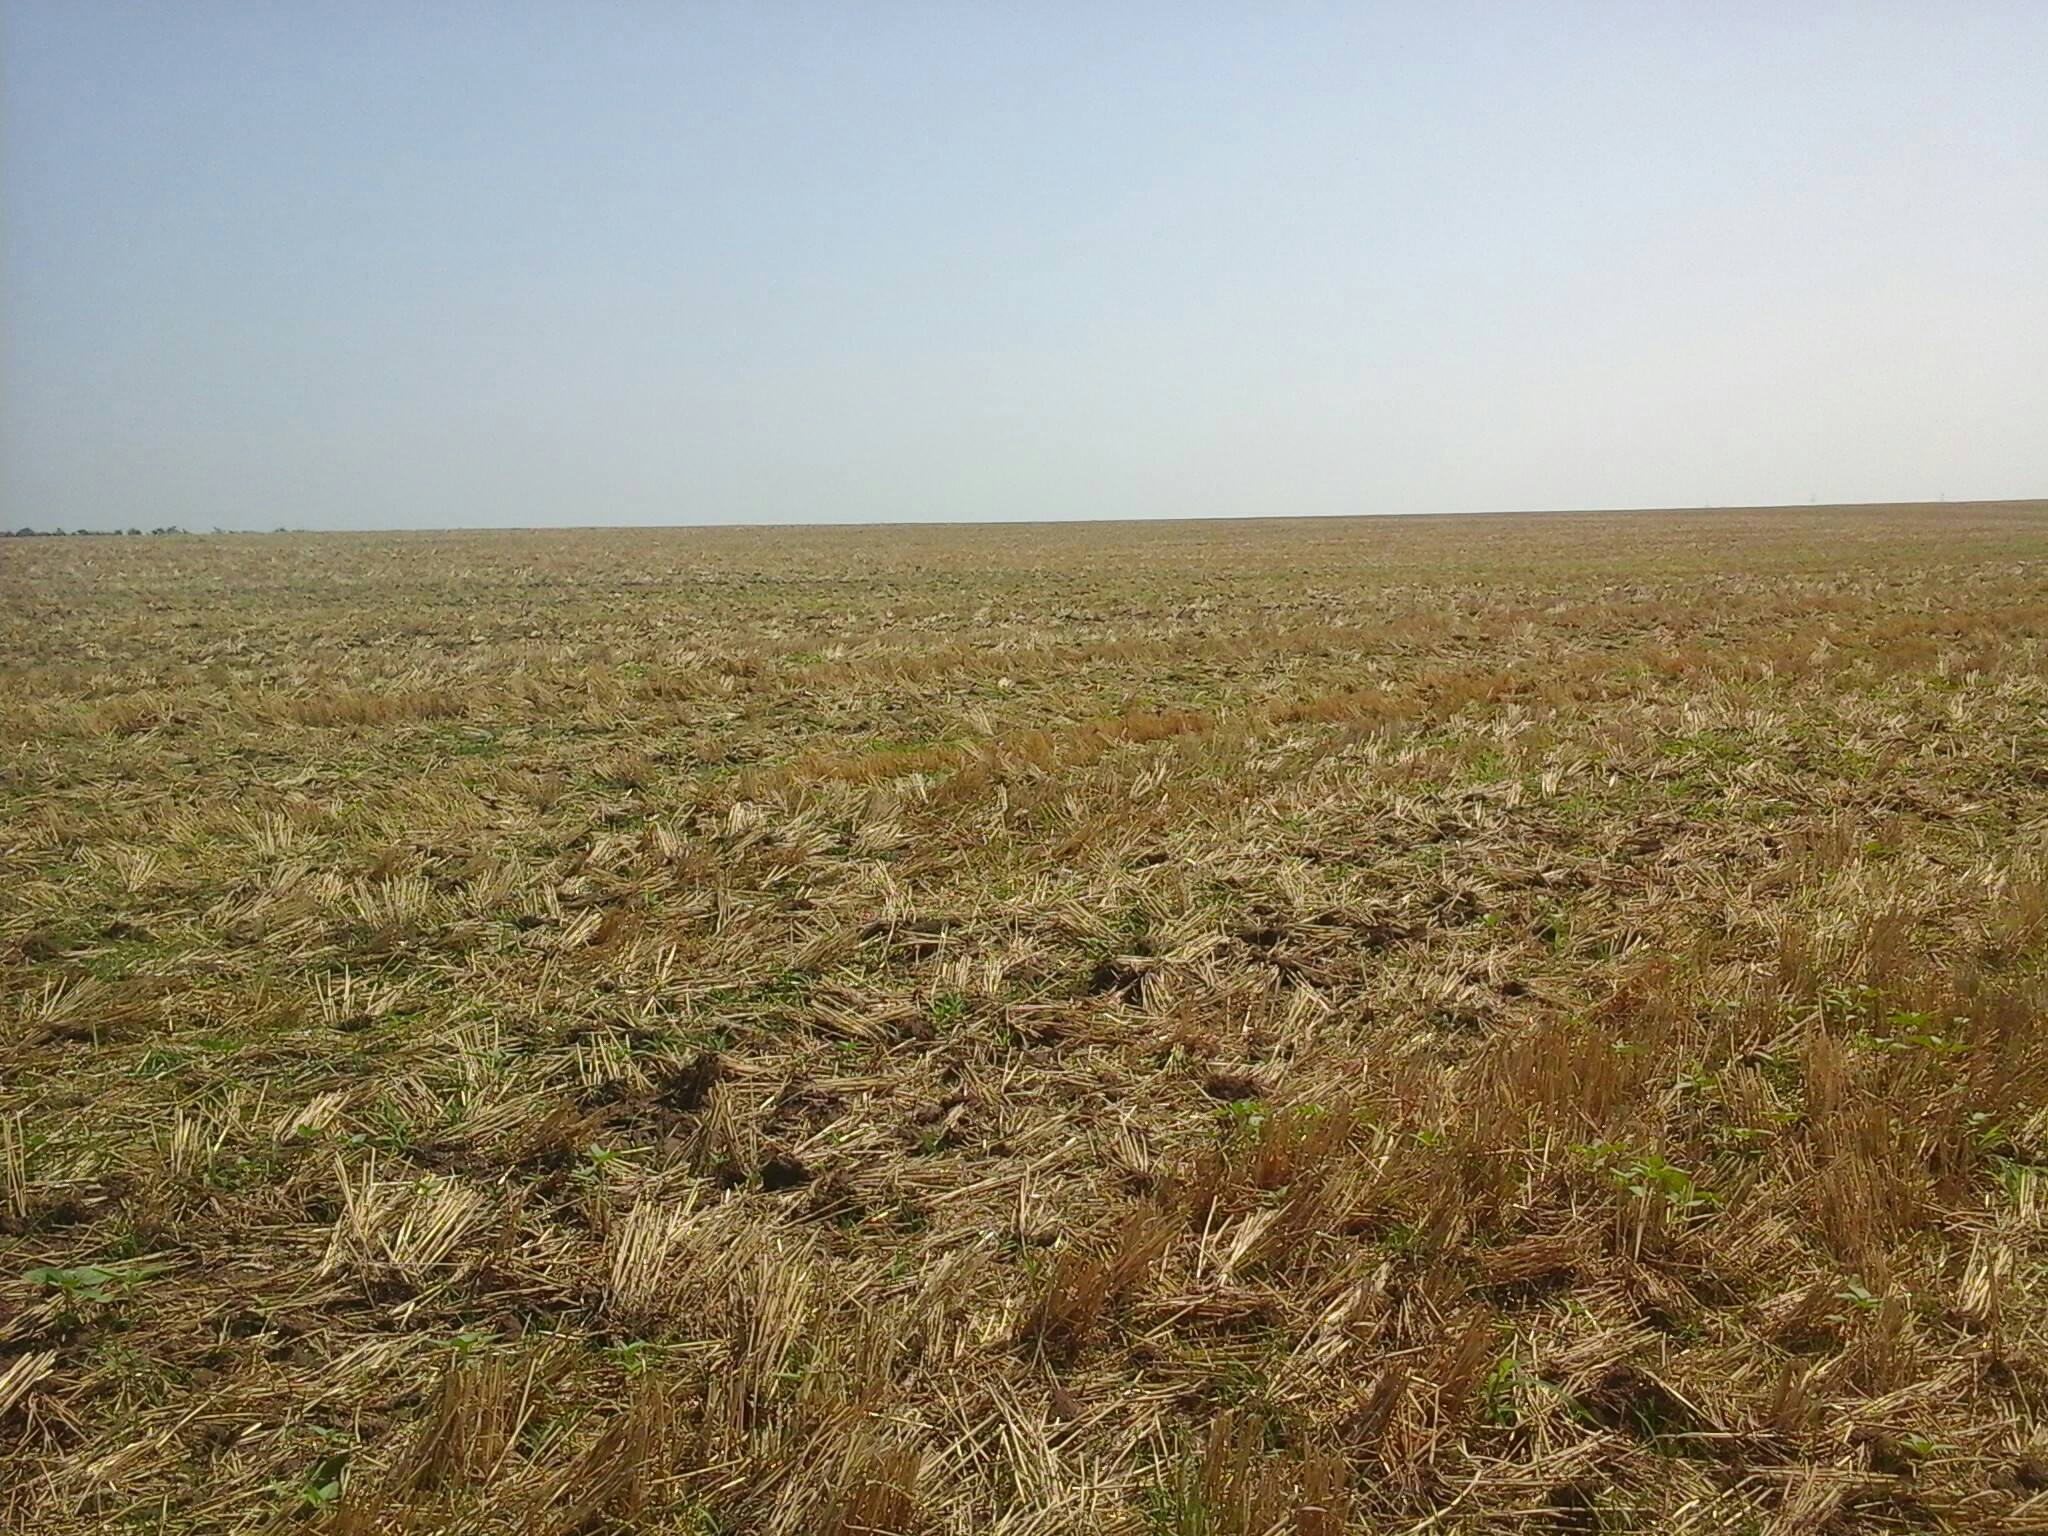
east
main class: Cropland
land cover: Common wheat
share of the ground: < 10 %
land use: Agriculture (excluding fallow land and kitchen gardens)
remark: Harvested field
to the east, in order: Common wheat
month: August
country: HU
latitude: 47.3479
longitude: 18.5516
